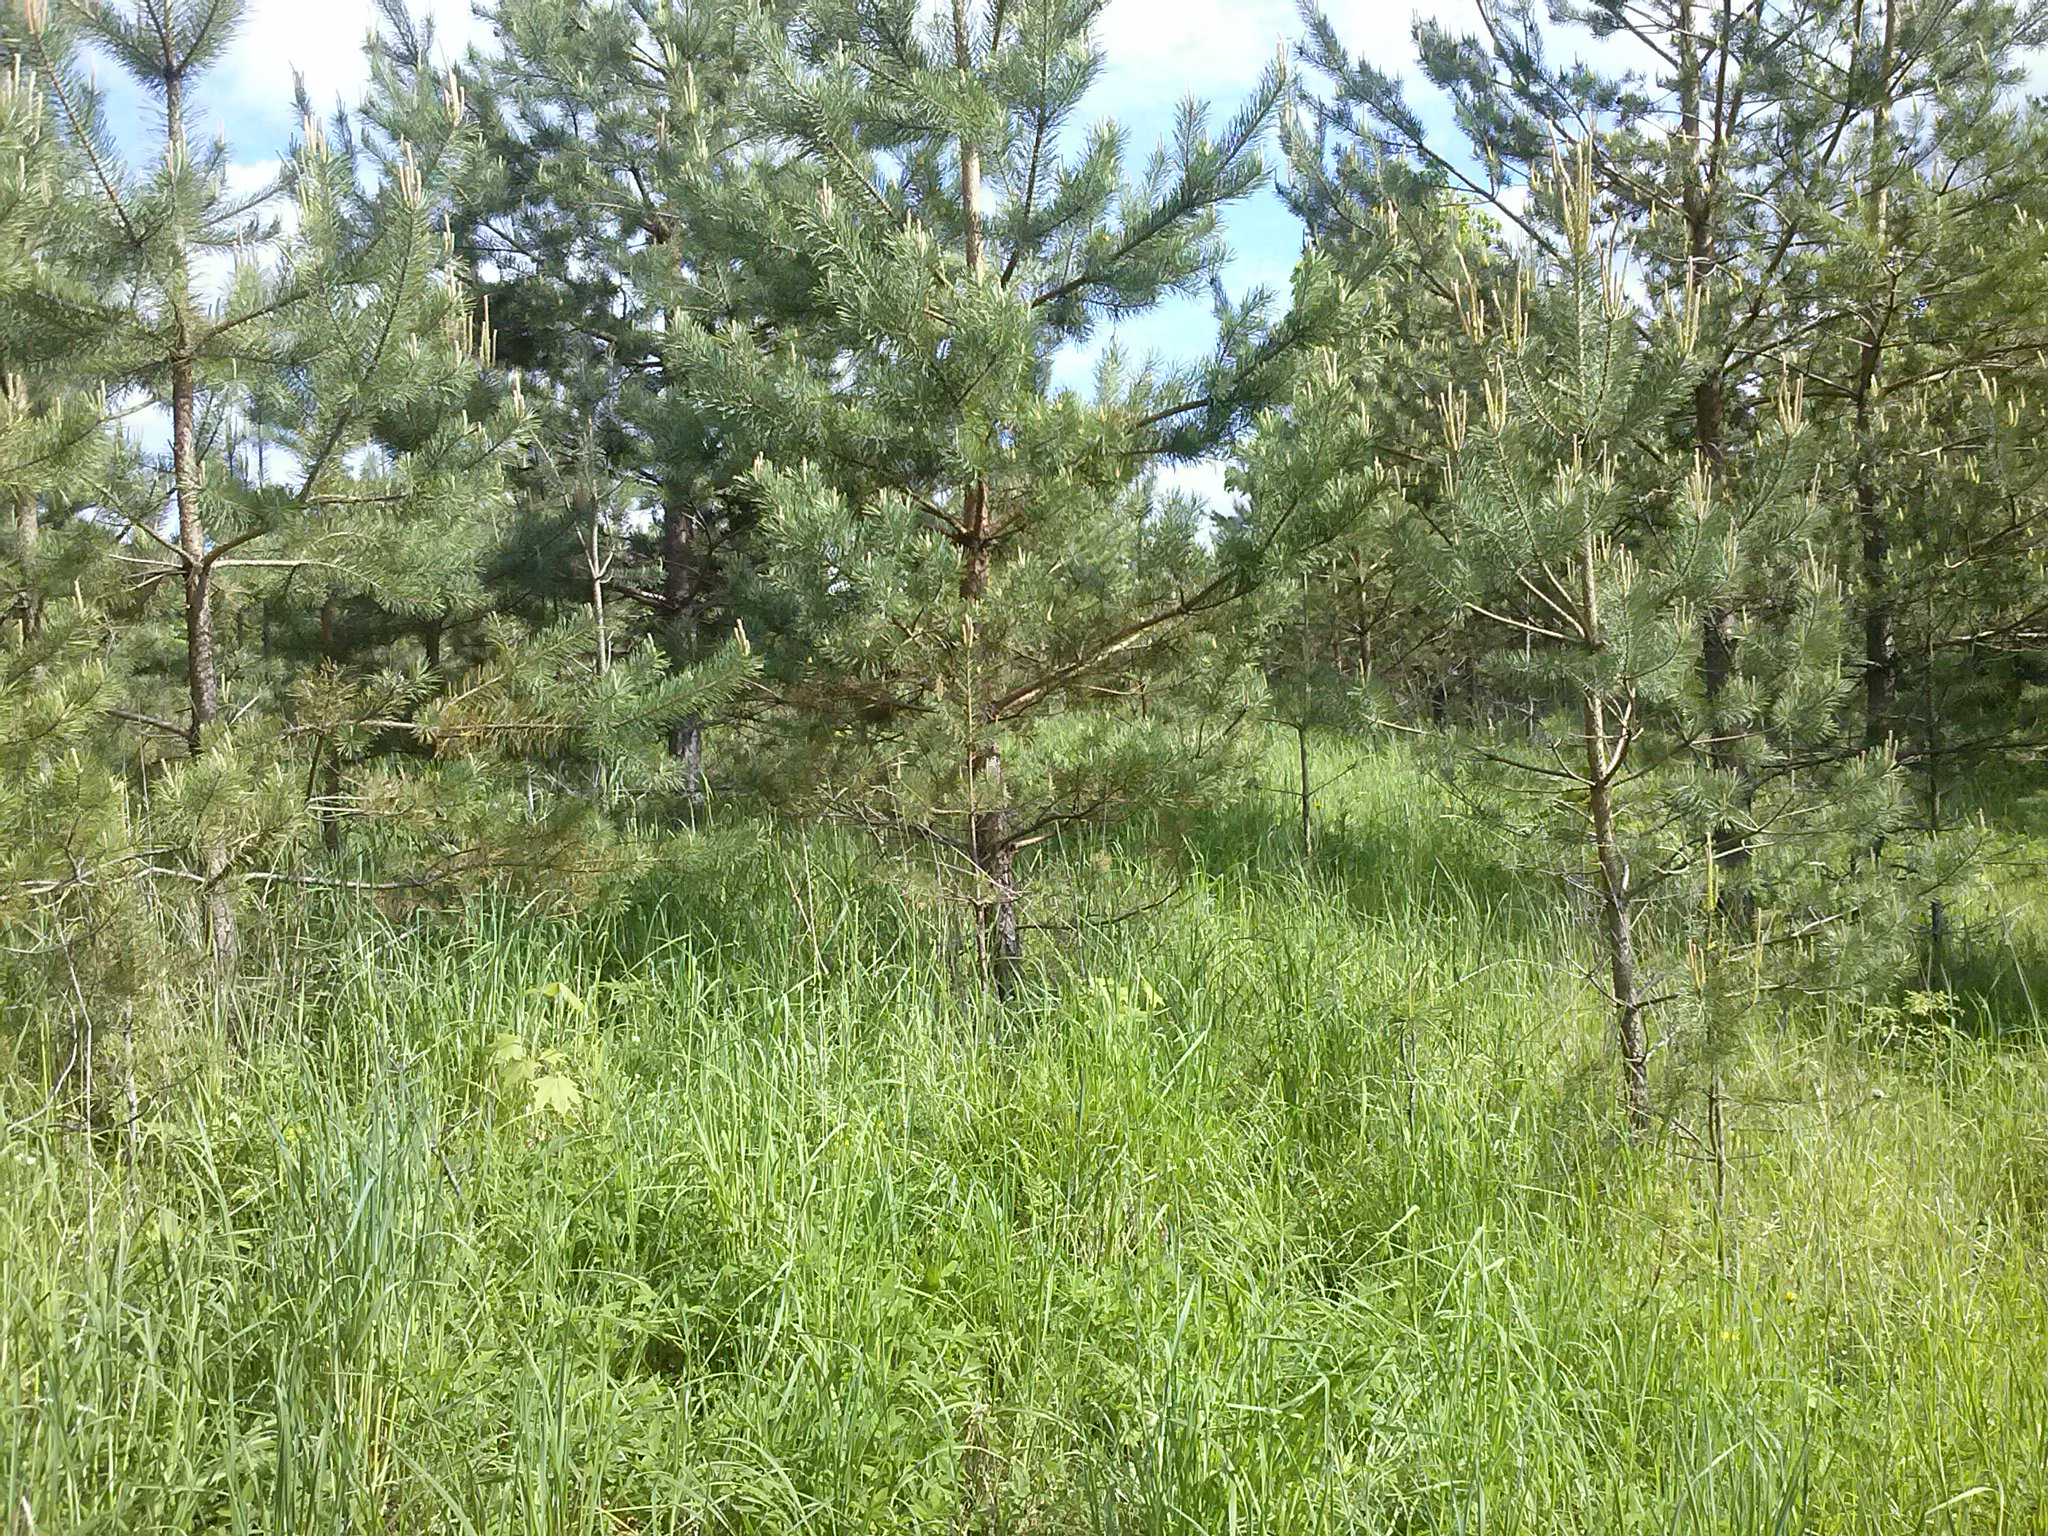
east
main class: Woodland
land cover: Pine dominated mixed woodland
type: hemiboreal forest and nemoral coniferous forest and mixed broadleaved-coniferous forest
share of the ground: > 75 %
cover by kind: coniferous forest trees 55 %, broadleaved forest trees 45 %
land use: Forestry
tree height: > 5 m
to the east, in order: Pine dominated mixed woodland; Broadleaved woodland; Grassland with sparse tree/shrub cover; Tracks; Spontaneously vegetated surfaces; Grassland with sparse tree/shrub cover; Spontaneously vegetated surfaces; Broadleaved woodland
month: May
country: LV
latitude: 56.2528
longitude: 27.8333
